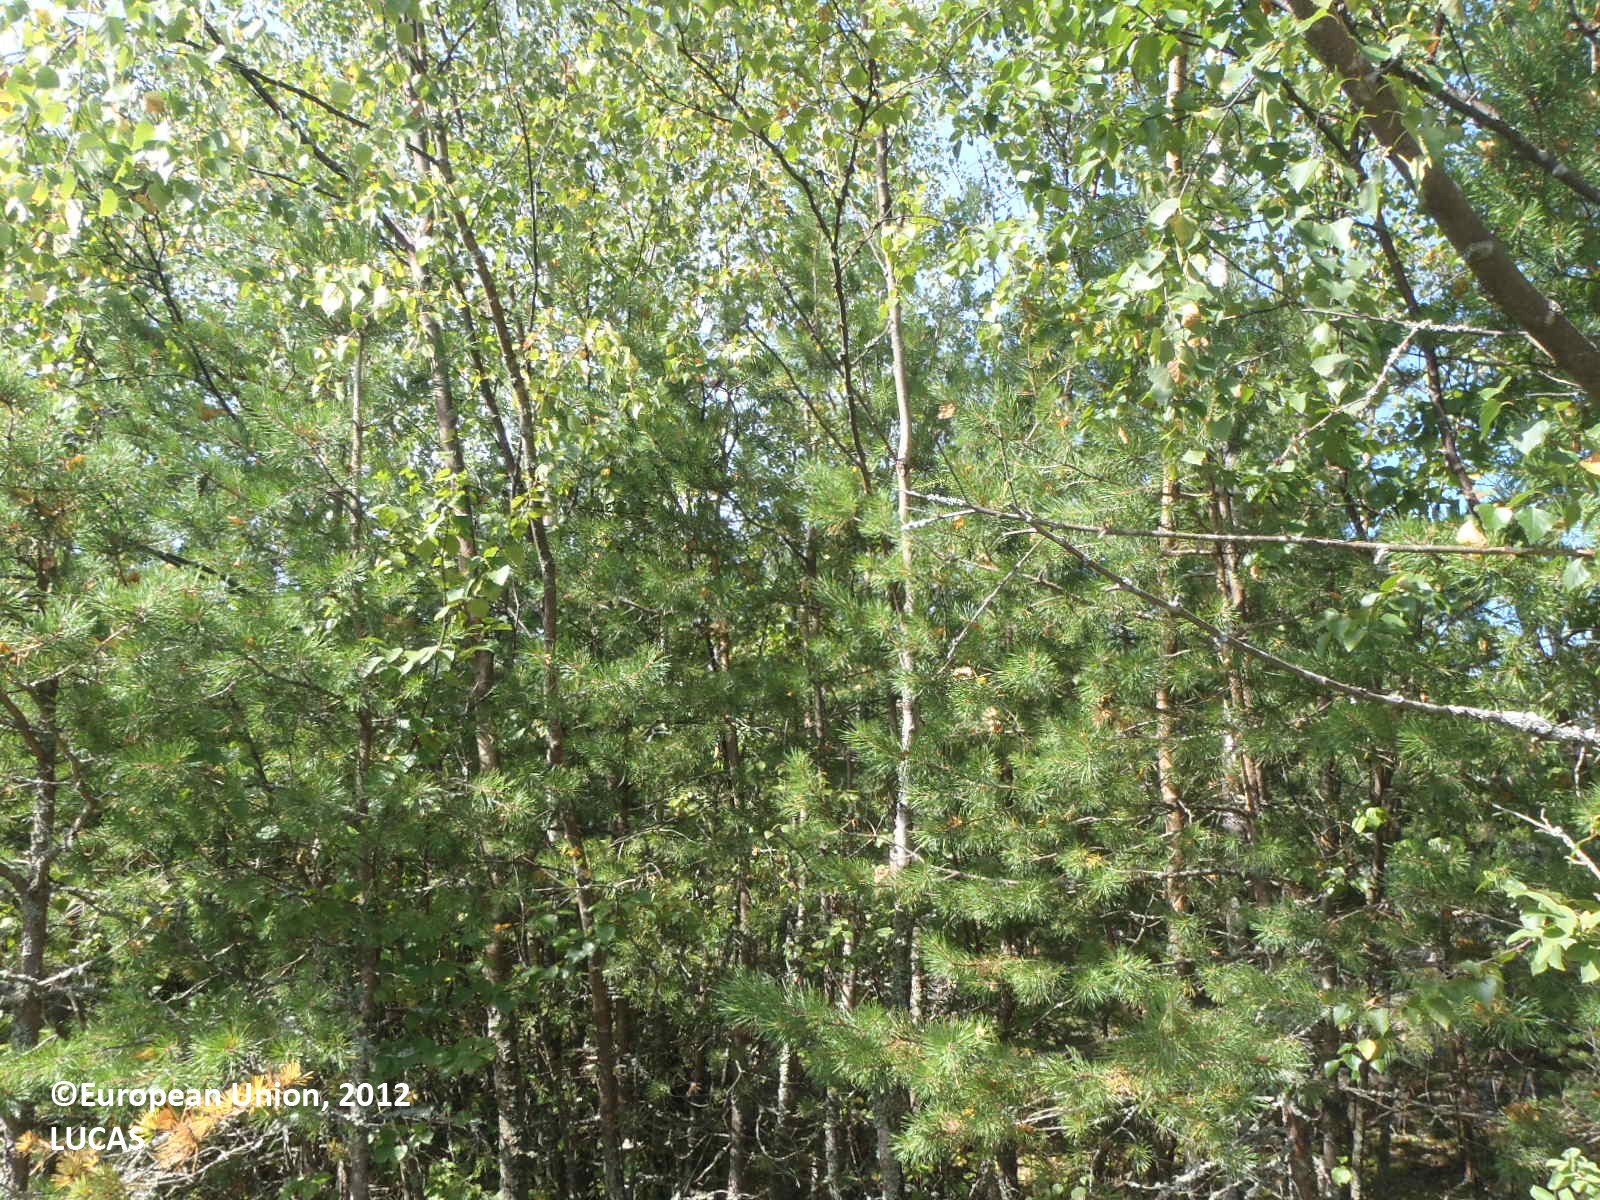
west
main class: Woodland
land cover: Pine dominated mixed woodland
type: hemiboreal forest and nemoral coniferous forest and mixed broadleaved-coniferous forest
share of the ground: 50 - 75 %
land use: Forestry
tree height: > 5 m
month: August
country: FI
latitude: 60.2526
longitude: 20.3627
